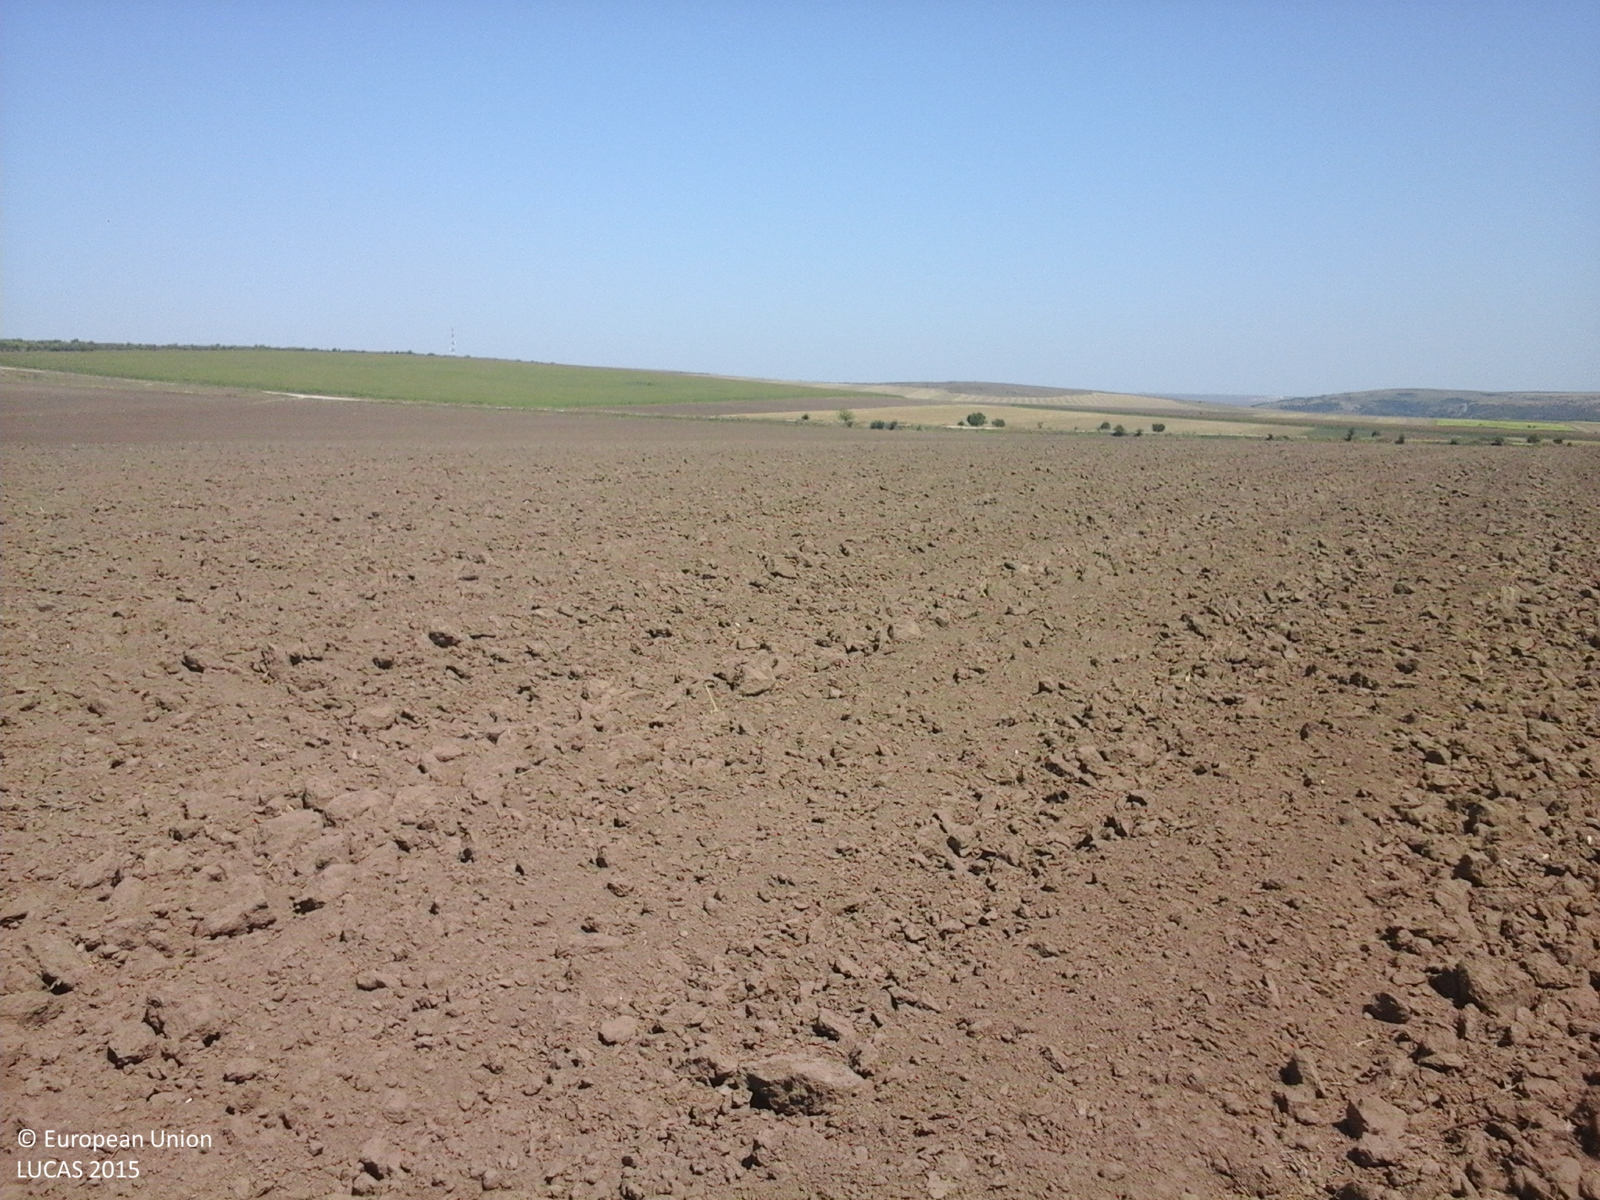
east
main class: Cropland
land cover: Durum wheat
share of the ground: < 10 %
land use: Agriculture (excluding fallow land and kitchen gardens)
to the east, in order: Durum wheat
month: August
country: RO
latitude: 44.4718
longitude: 28.4369
